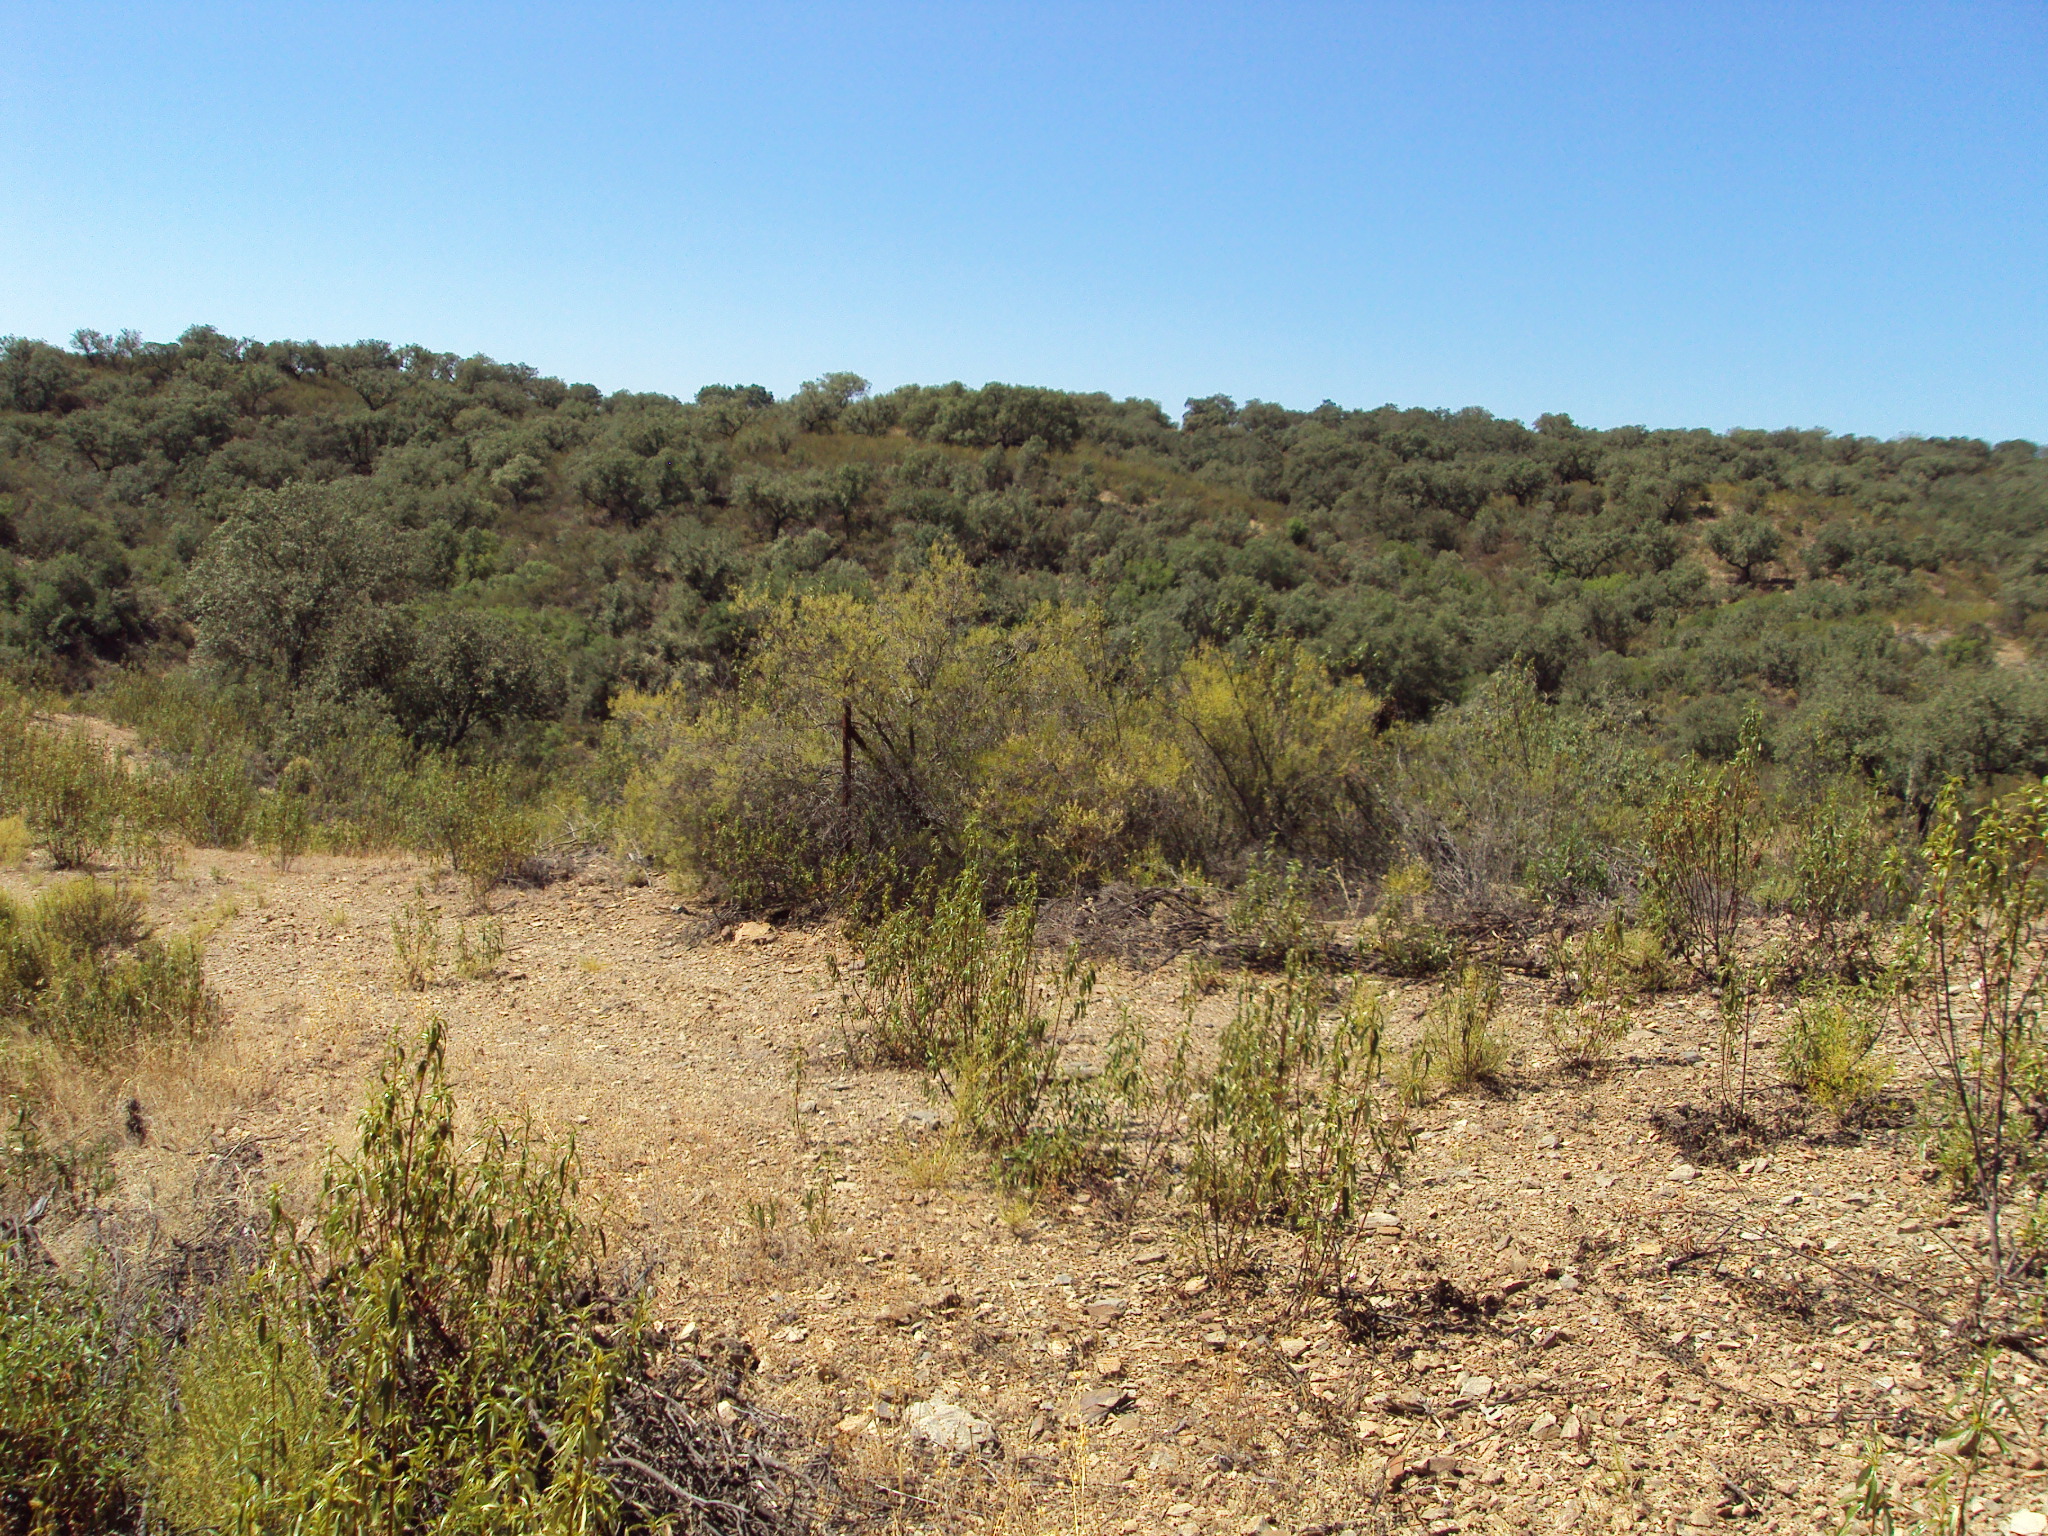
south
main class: Woodland
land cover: Broadleaved woodland
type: broadleaved evergreen forest
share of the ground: 10 - 25 %
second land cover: Spontaneously vegetated surfaces
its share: > 75 %
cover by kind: shrubs 80 %, broadleaved forest trees 20 %
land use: Forestry
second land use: Agriculture (excluding fallow land and kitchen gardens)
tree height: < 5 m
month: July
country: ES
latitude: 37.4507
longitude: -7.0569
